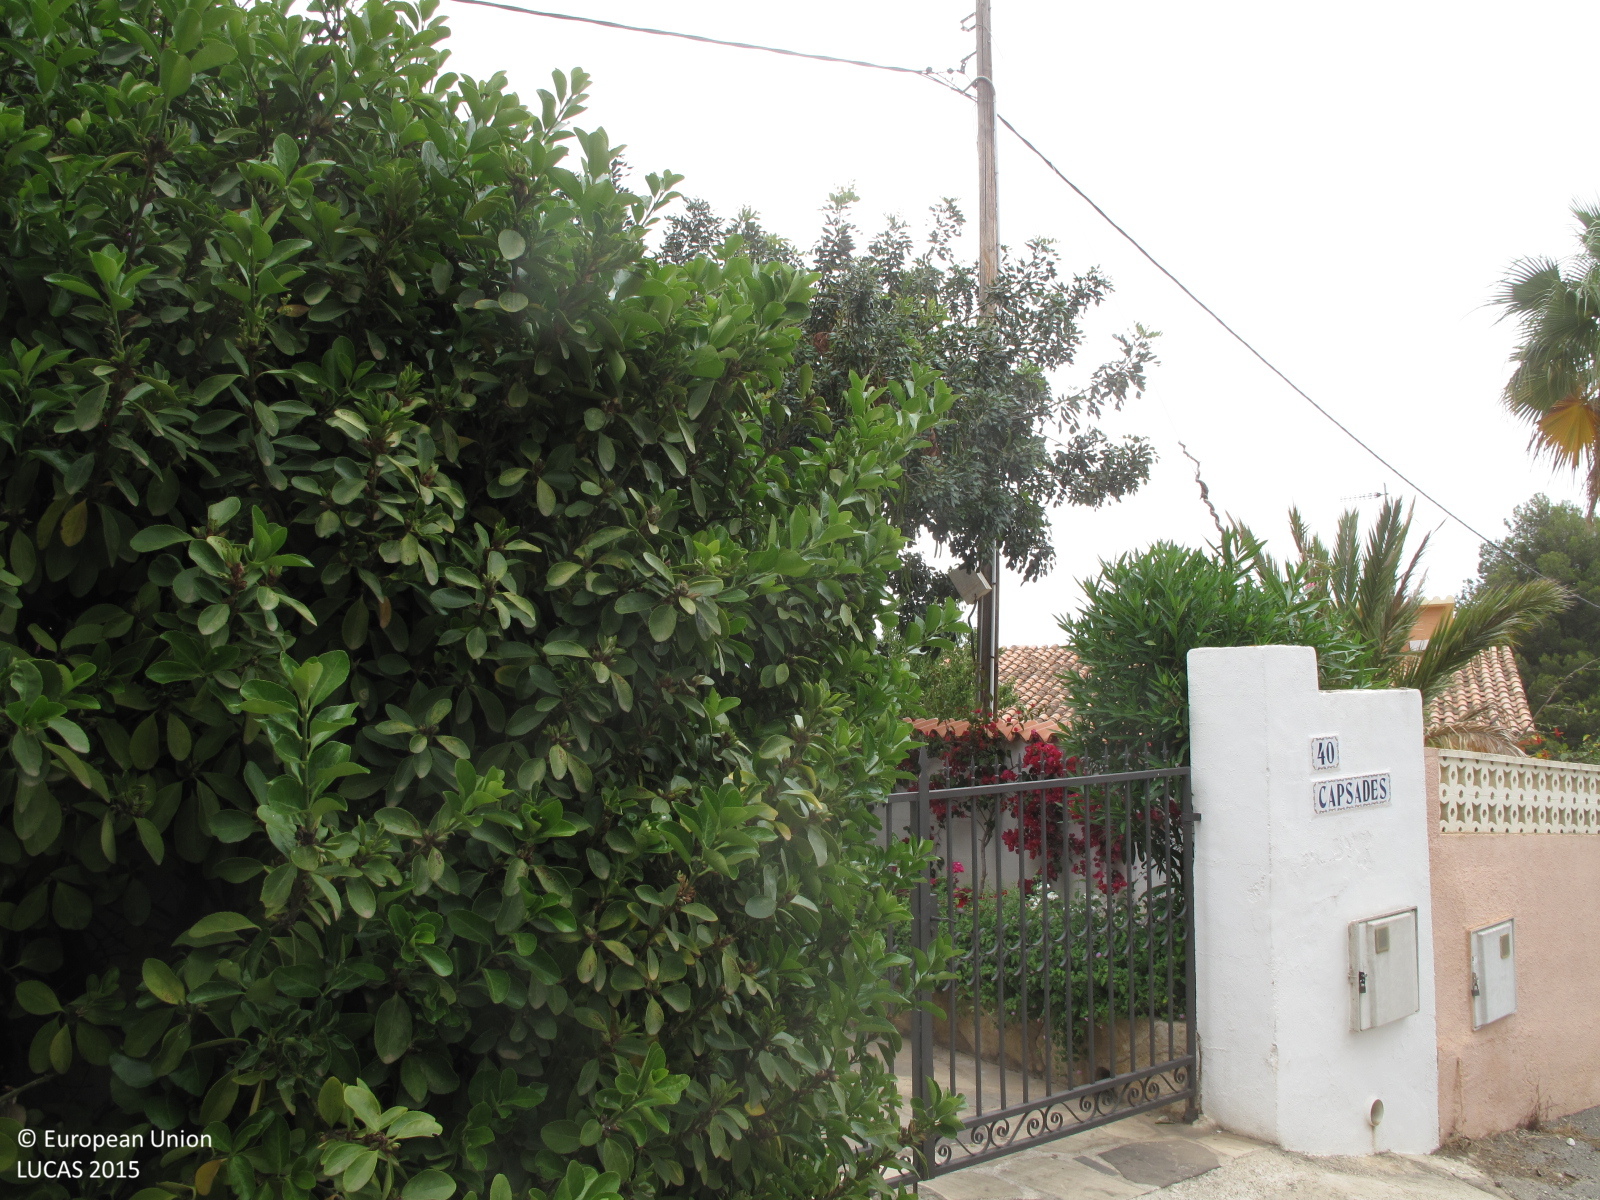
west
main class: Grassland
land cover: Grassland with sparse tree/shrub cover
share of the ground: > 75 %
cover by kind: herbaceous plants 95 %, broadleaved forest trees 5 %
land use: Residential
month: May
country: ES
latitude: 38.8194
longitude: 0.1179
